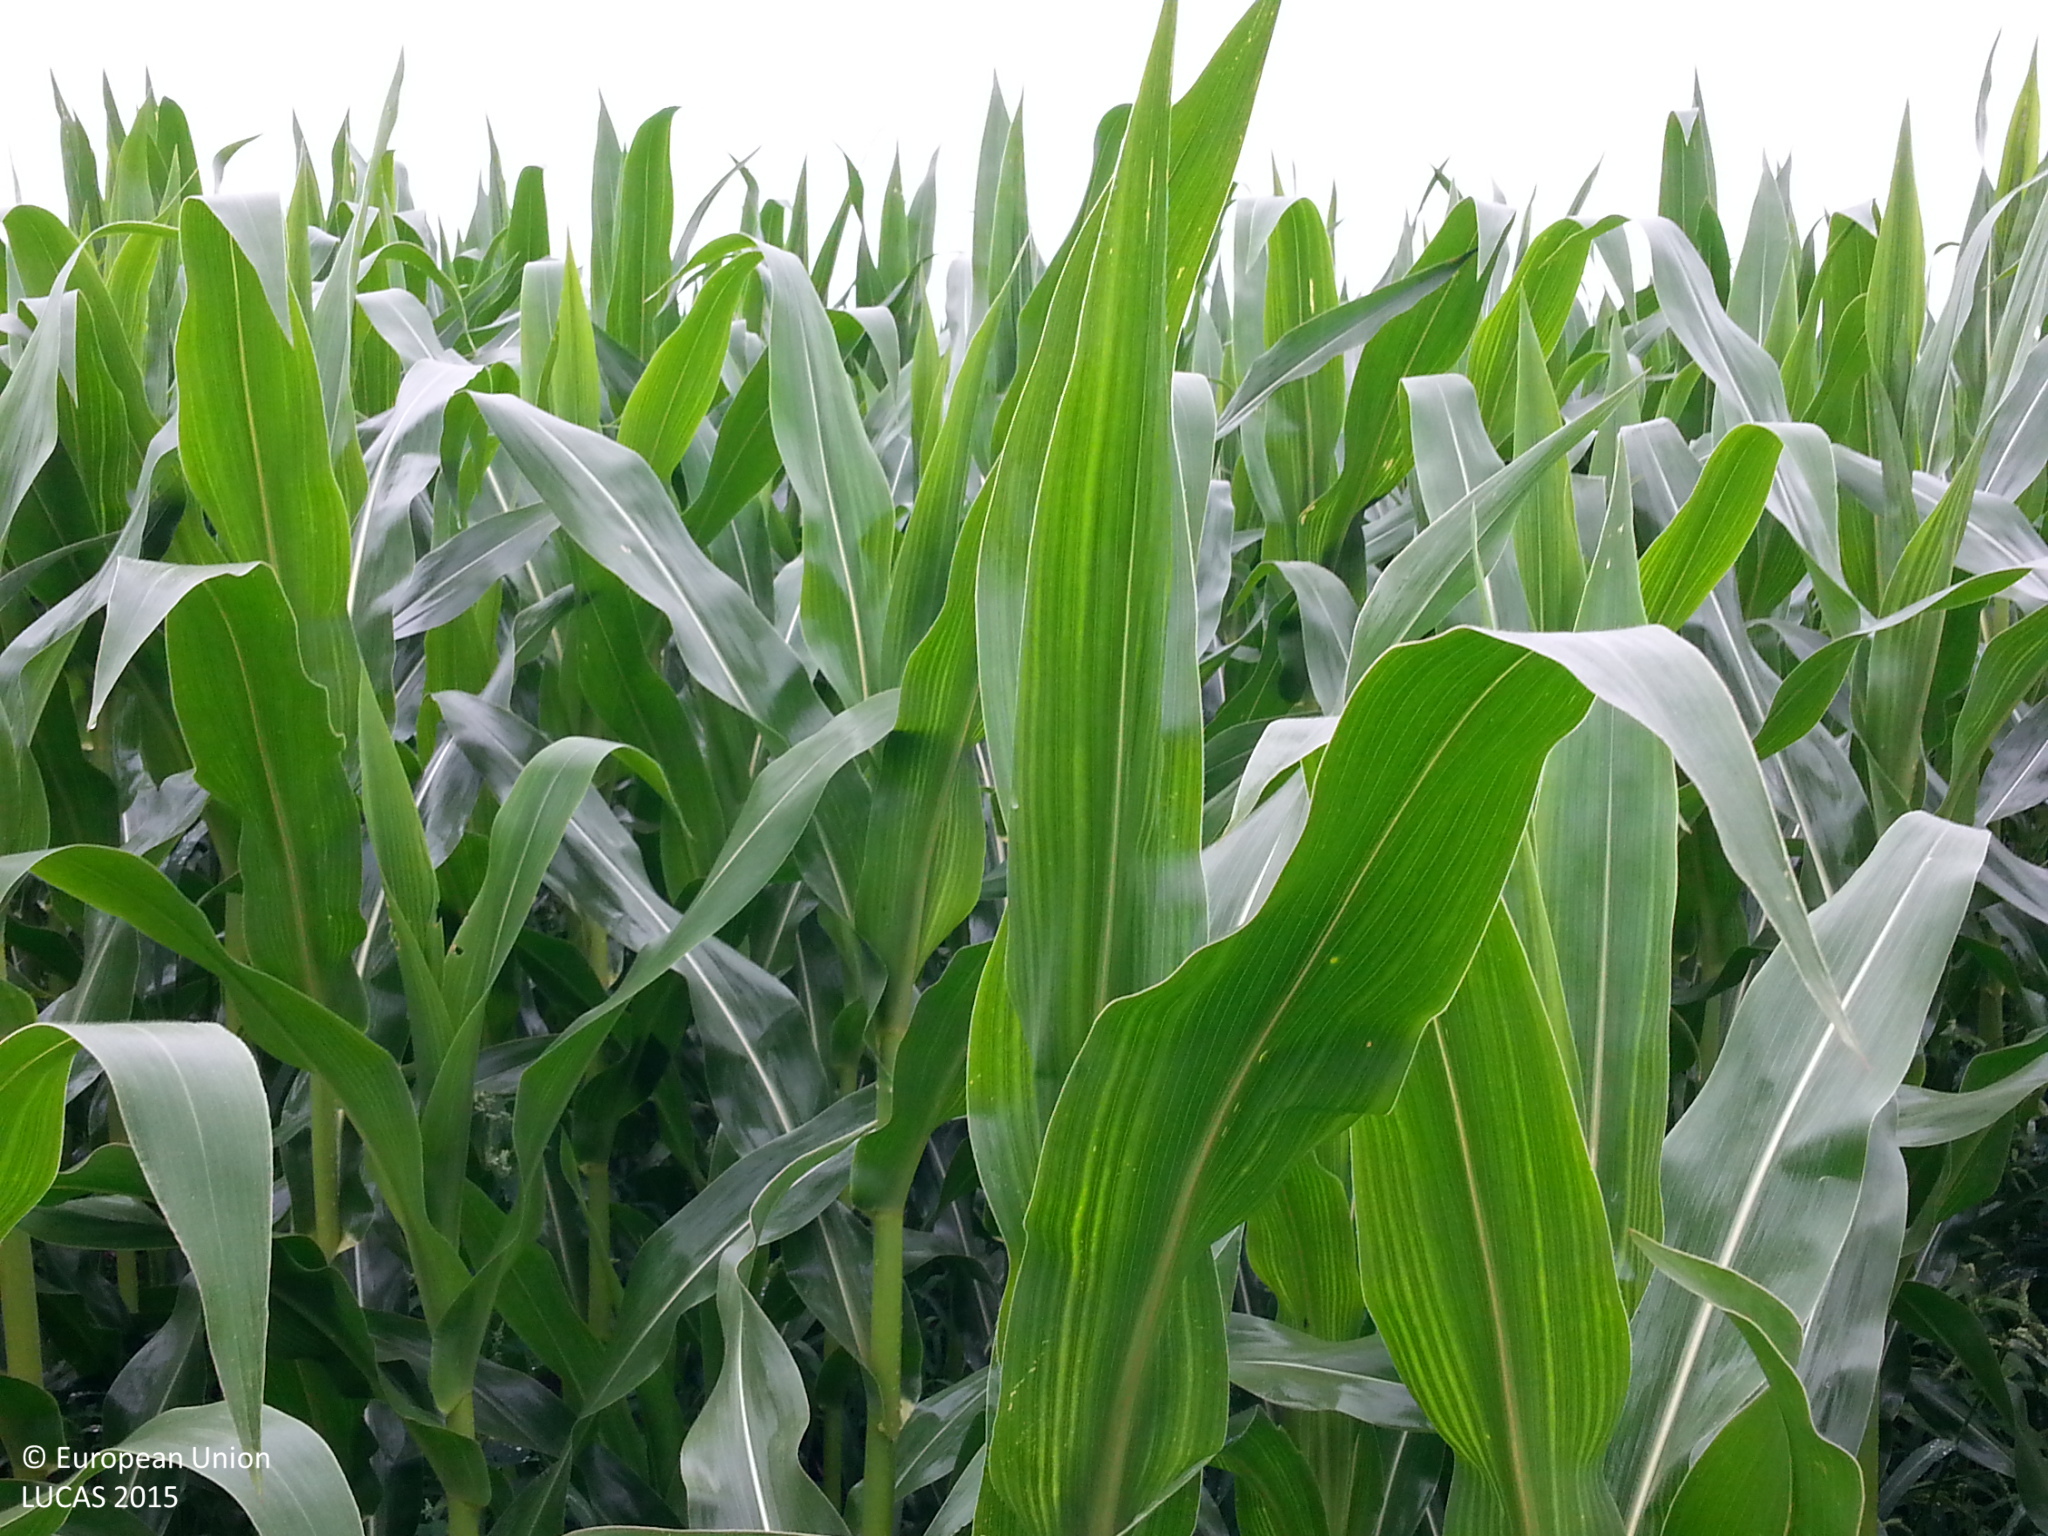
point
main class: Cropland
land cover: Maize
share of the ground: > 75 %
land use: Agriculture (excluding fallow land and kitchen gardens)
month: July
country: DE
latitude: 52.9836
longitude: 11.0869
